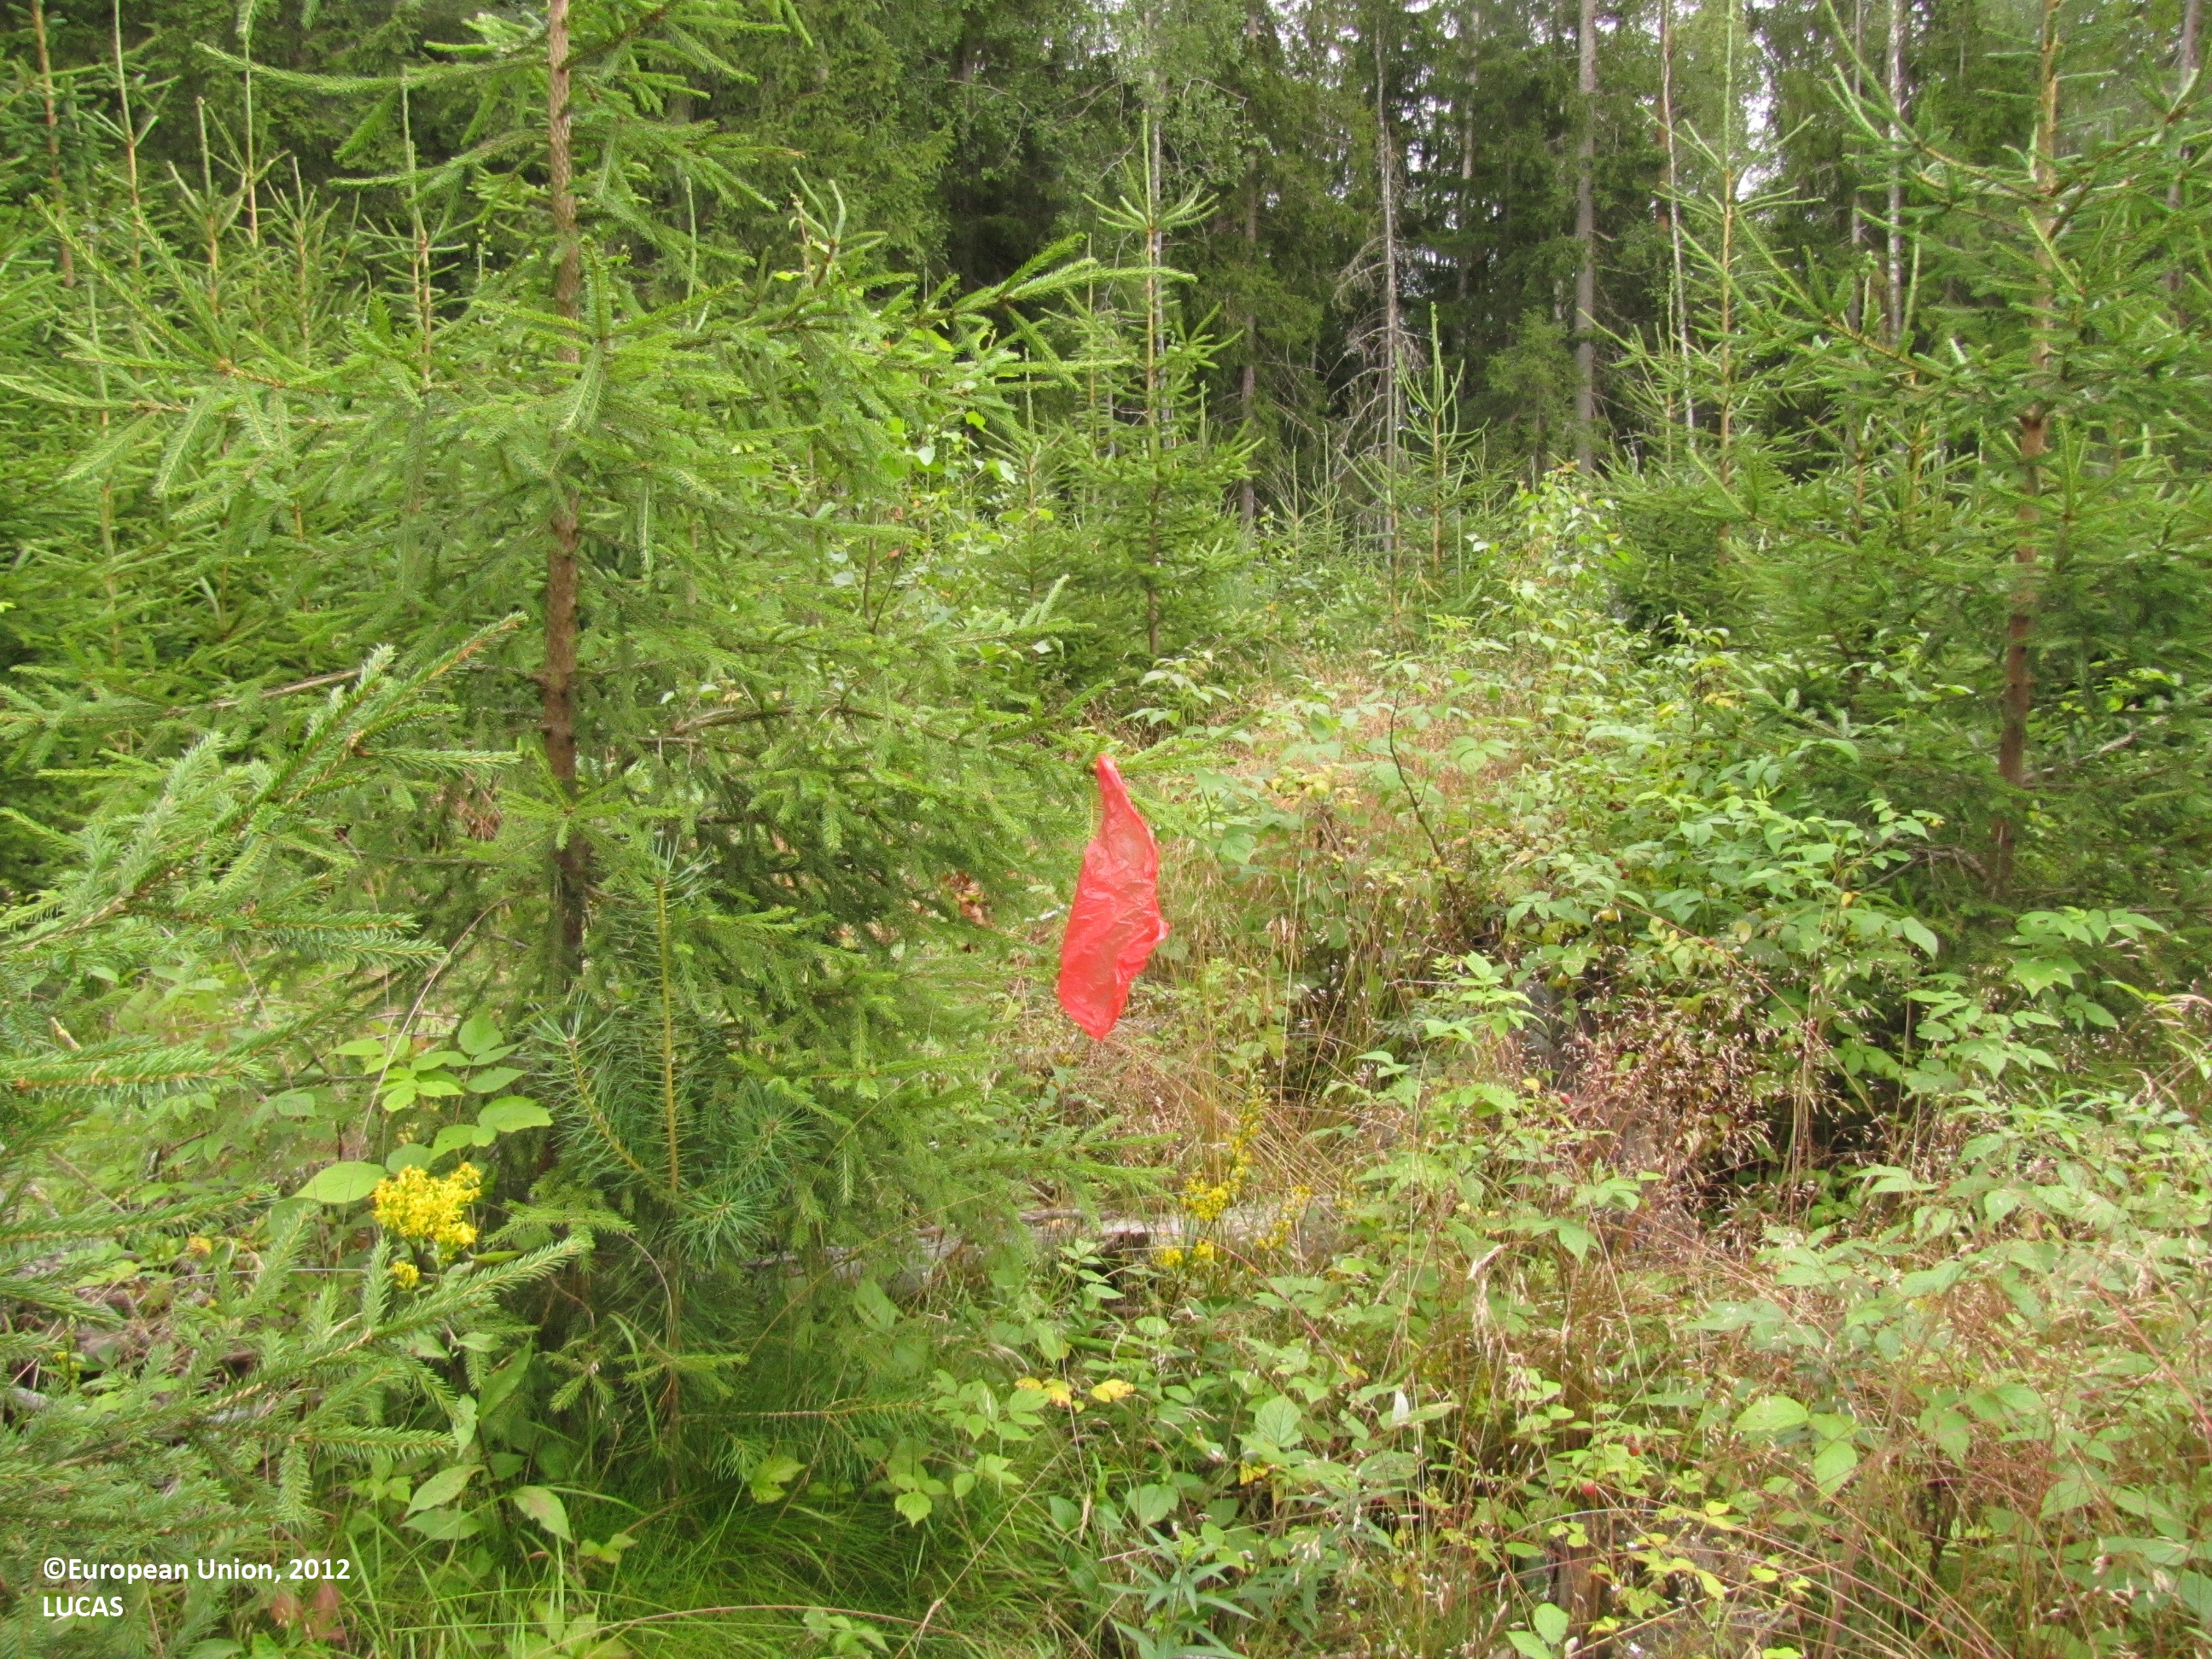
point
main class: Woodland
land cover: Spruce dominated coniferous woodland
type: boreal forest
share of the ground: 25 - 50 %
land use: Forestry
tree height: < 5 m
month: August
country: FI
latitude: 61.8449
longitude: 23.1987
